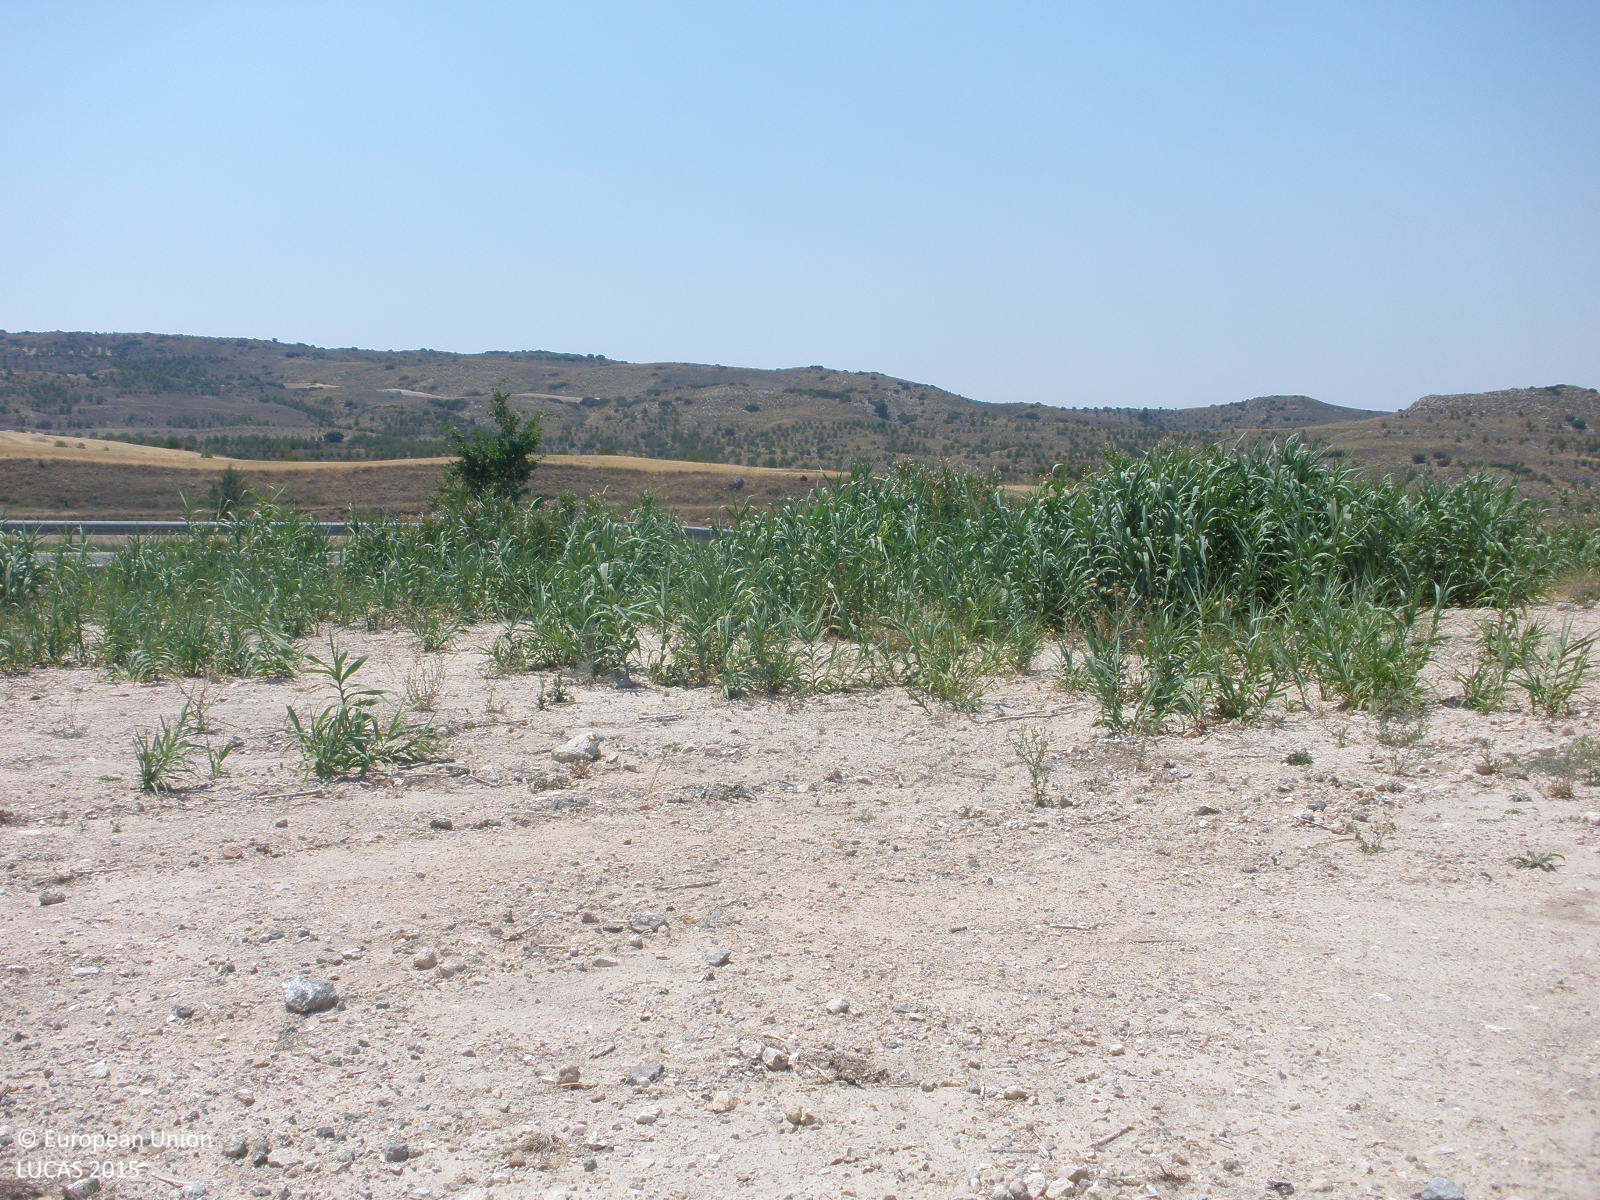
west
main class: Grassland
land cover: Spontaneously vegetated surfaces
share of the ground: 25 - 50 %
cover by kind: unconsolidated bare surface 75 %, herbaceous plants 25 %
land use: Semi-natural and natural areas not in use
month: June
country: ES
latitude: 40.2309
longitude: -3.2039
